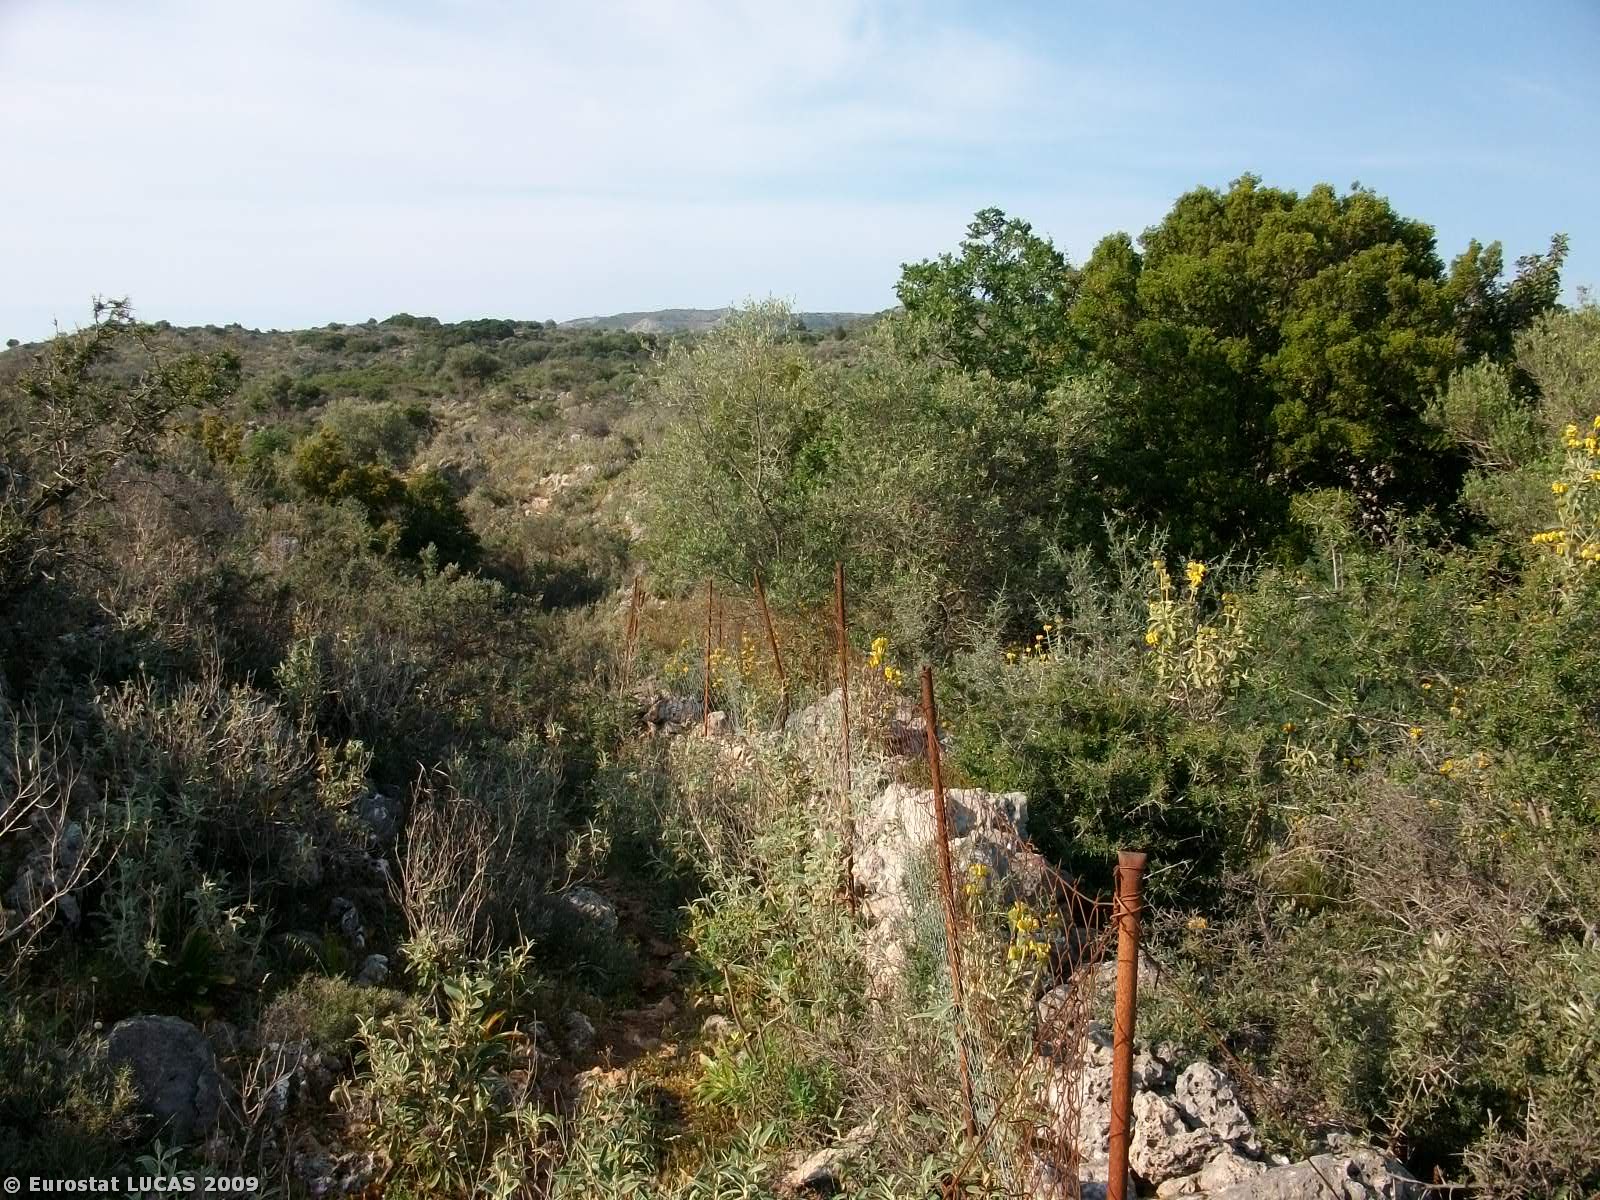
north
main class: Shrubland
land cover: Shrubland with sparse tree cover
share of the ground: > 75 %
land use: Agriculture (excluding fallow land and kitchen gardens)
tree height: > 5 m
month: May
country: GR
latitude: 35.4209
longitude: 24.2265
